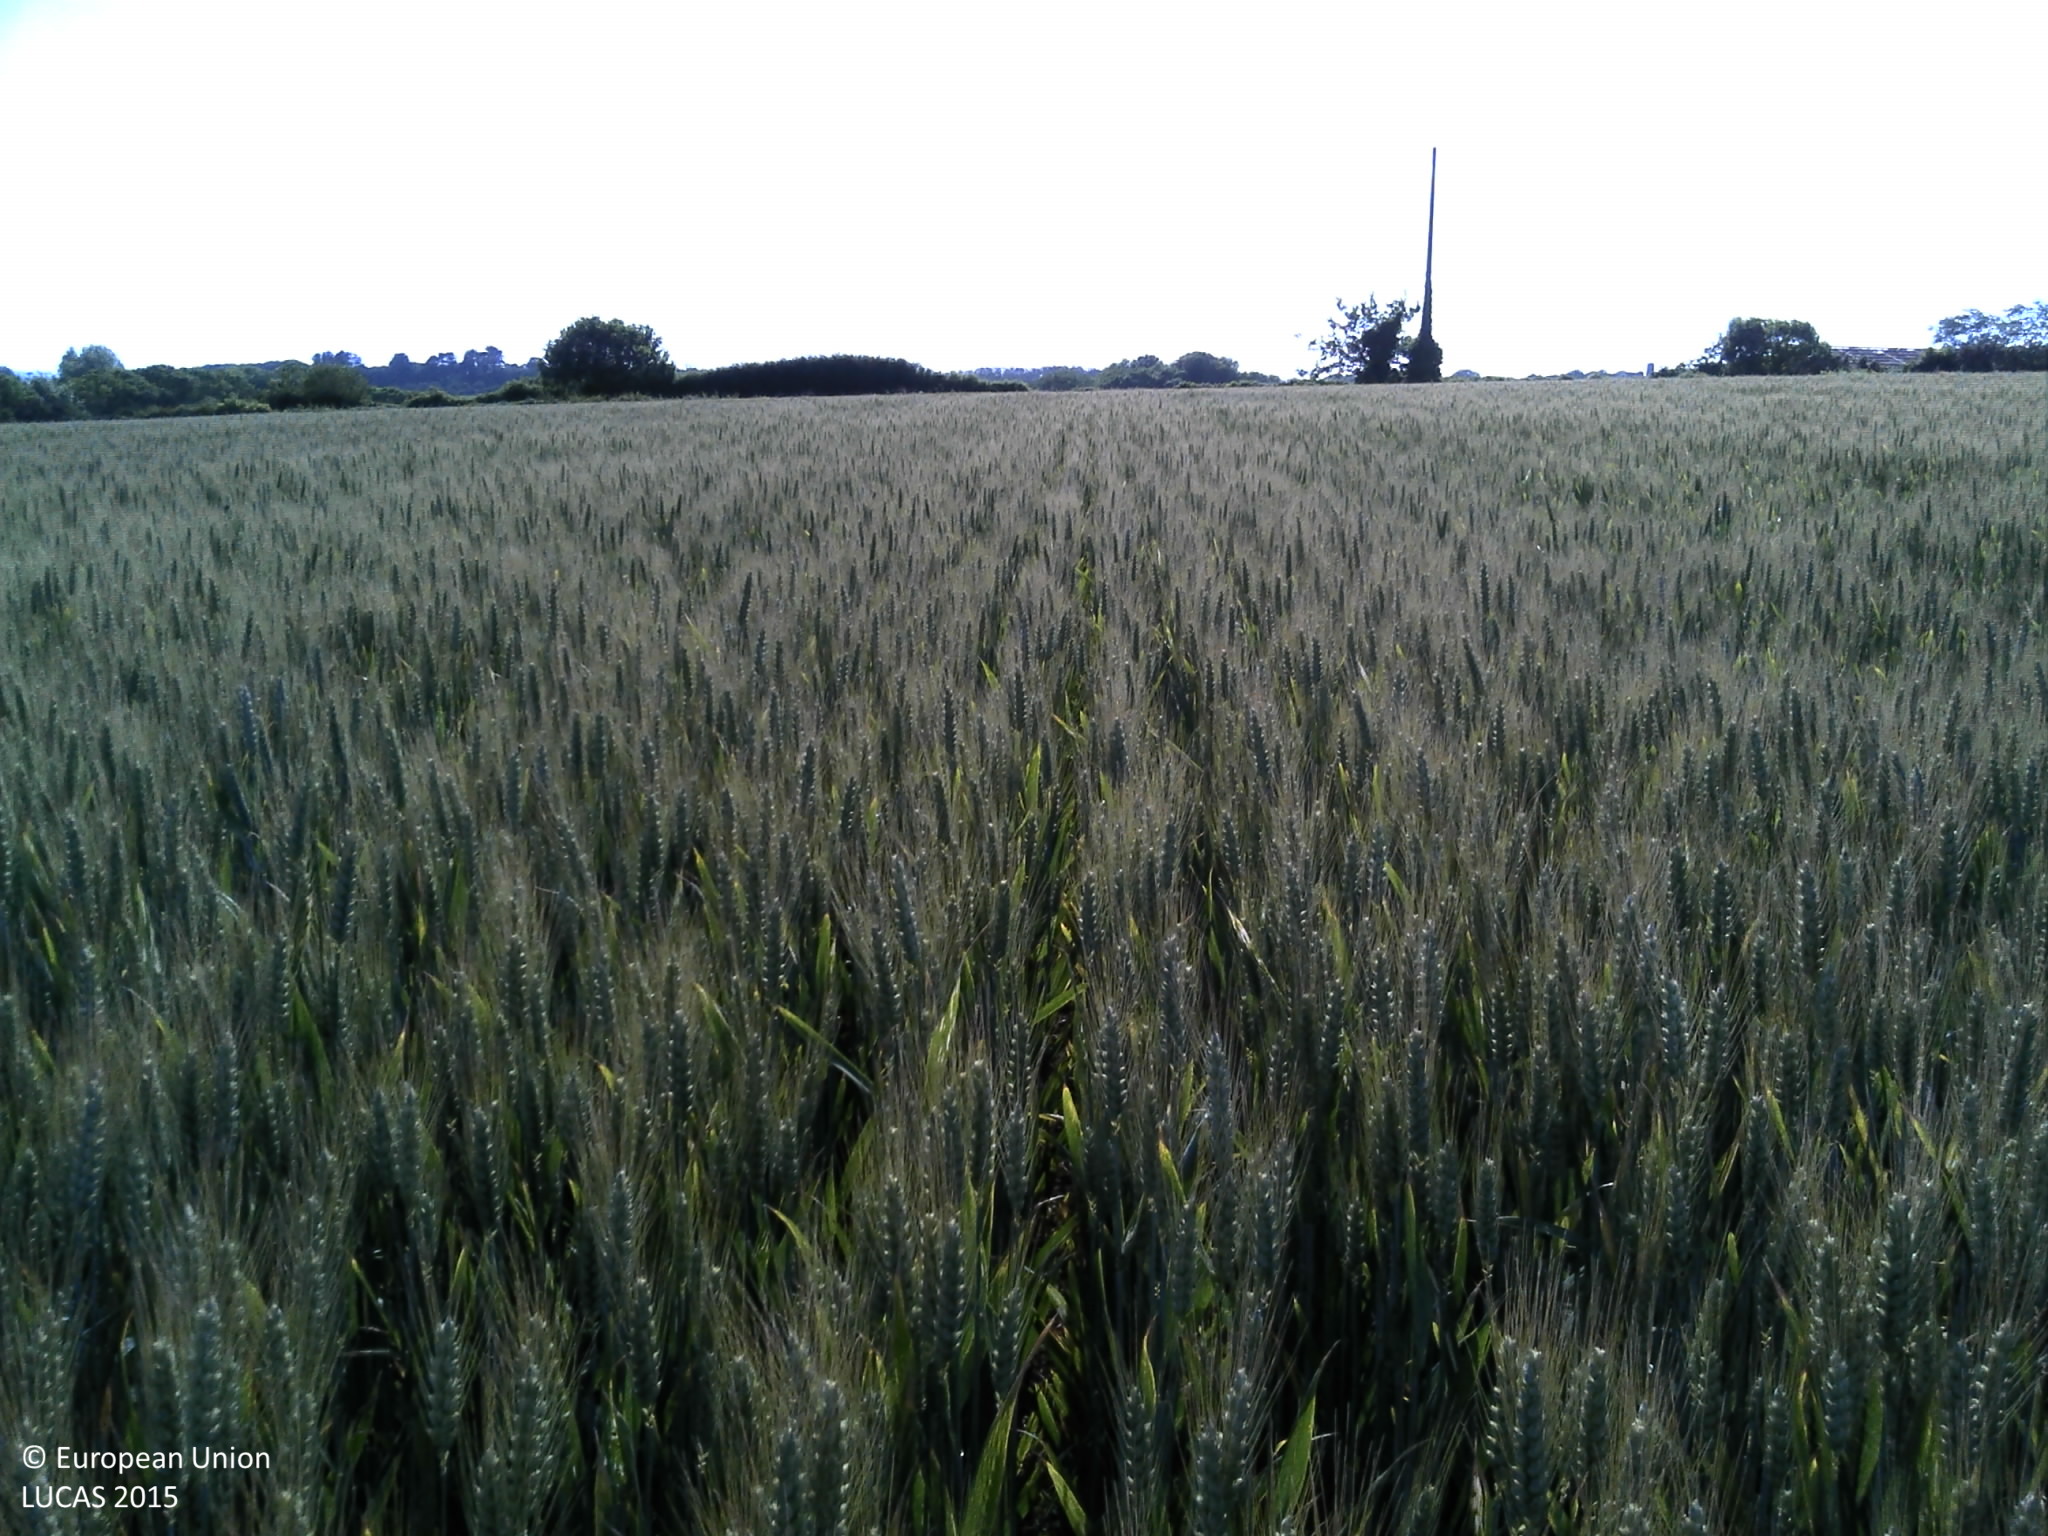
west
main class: Cropland
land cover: Common wheat
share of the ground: > 75 %
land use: Agriculture (excluding fallow land and kitchen gardens)
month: June
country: FR
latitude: 48.0738
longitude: -4.4161
